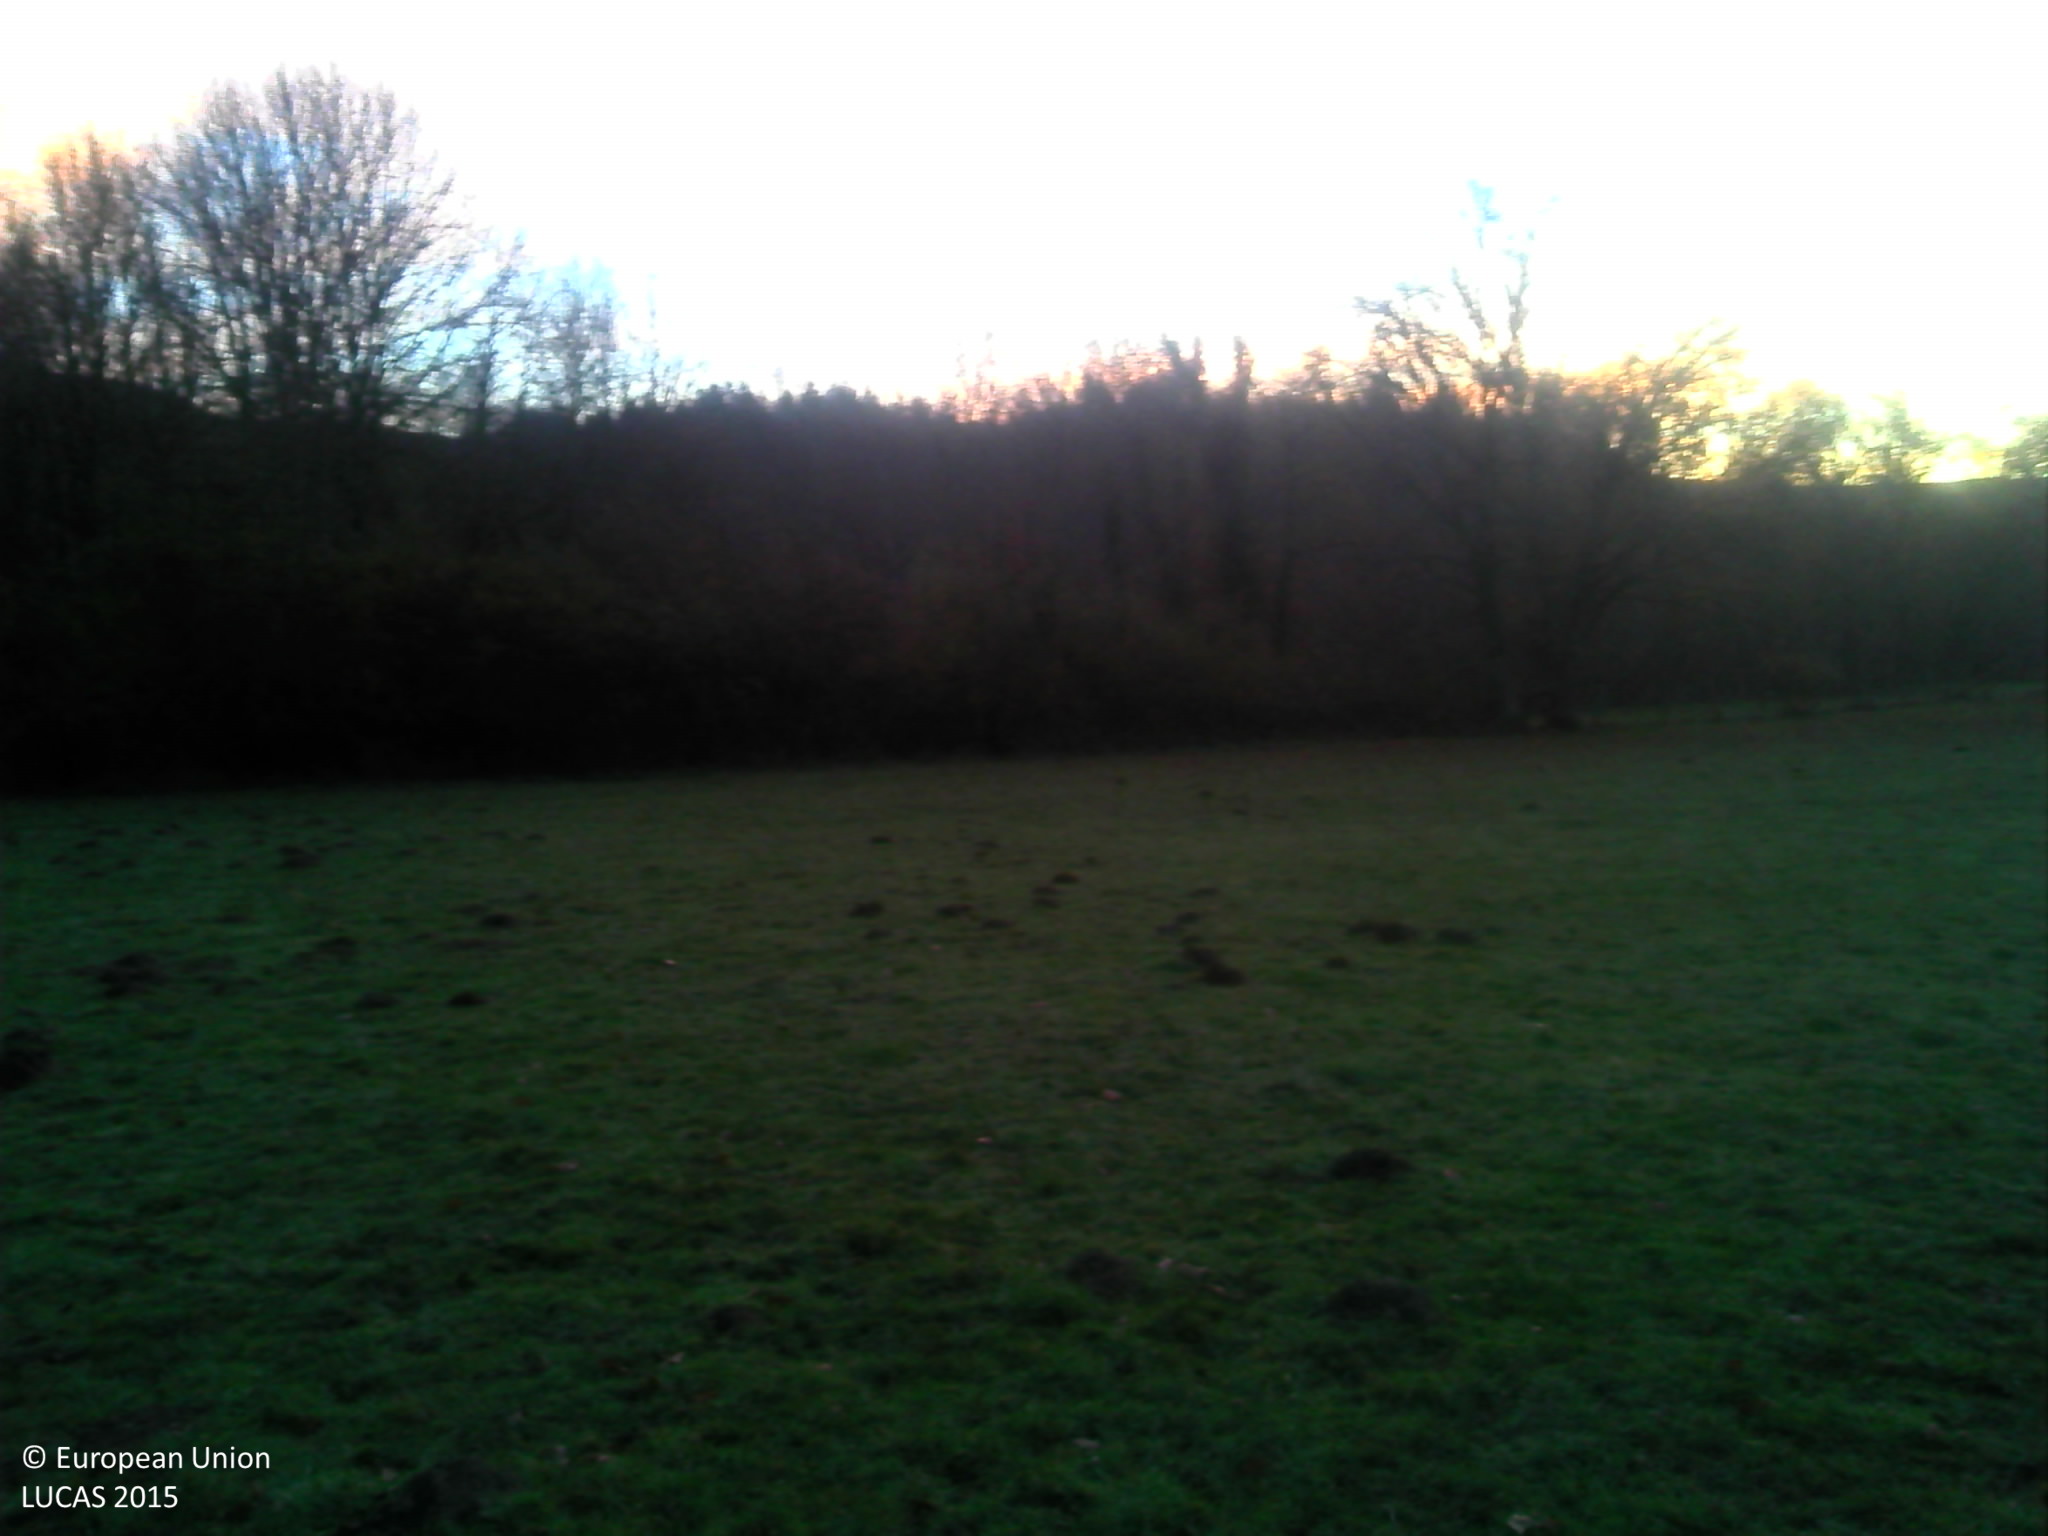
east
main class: Grassland
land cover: Grassland without tree/shrub cover
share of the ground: > 75 %
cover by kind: herbaceous plants 100 %
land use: Agriculture (excluding fallow land and kitchen gardens)
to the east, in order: Grassland without tree/shrub cover; Fences; Broadleaved woodland; Fences; Grassland without tree/shrub cover; Fences; Broadleaved woodland; Rivers and streams; Abandoned hedges; Grassland without tree/shrub cover; Fences; Abandoned hedges; Grass margins; Paved roads, cycling and walking lanes; Grass margins; Ditches and canals; Grass margins; Broadleaved woodland; Grass margins; Paved roads, cycling and walking lanes; Broadleaved woodland
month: November
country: FR
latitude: 46.0574
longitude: 3.7058
